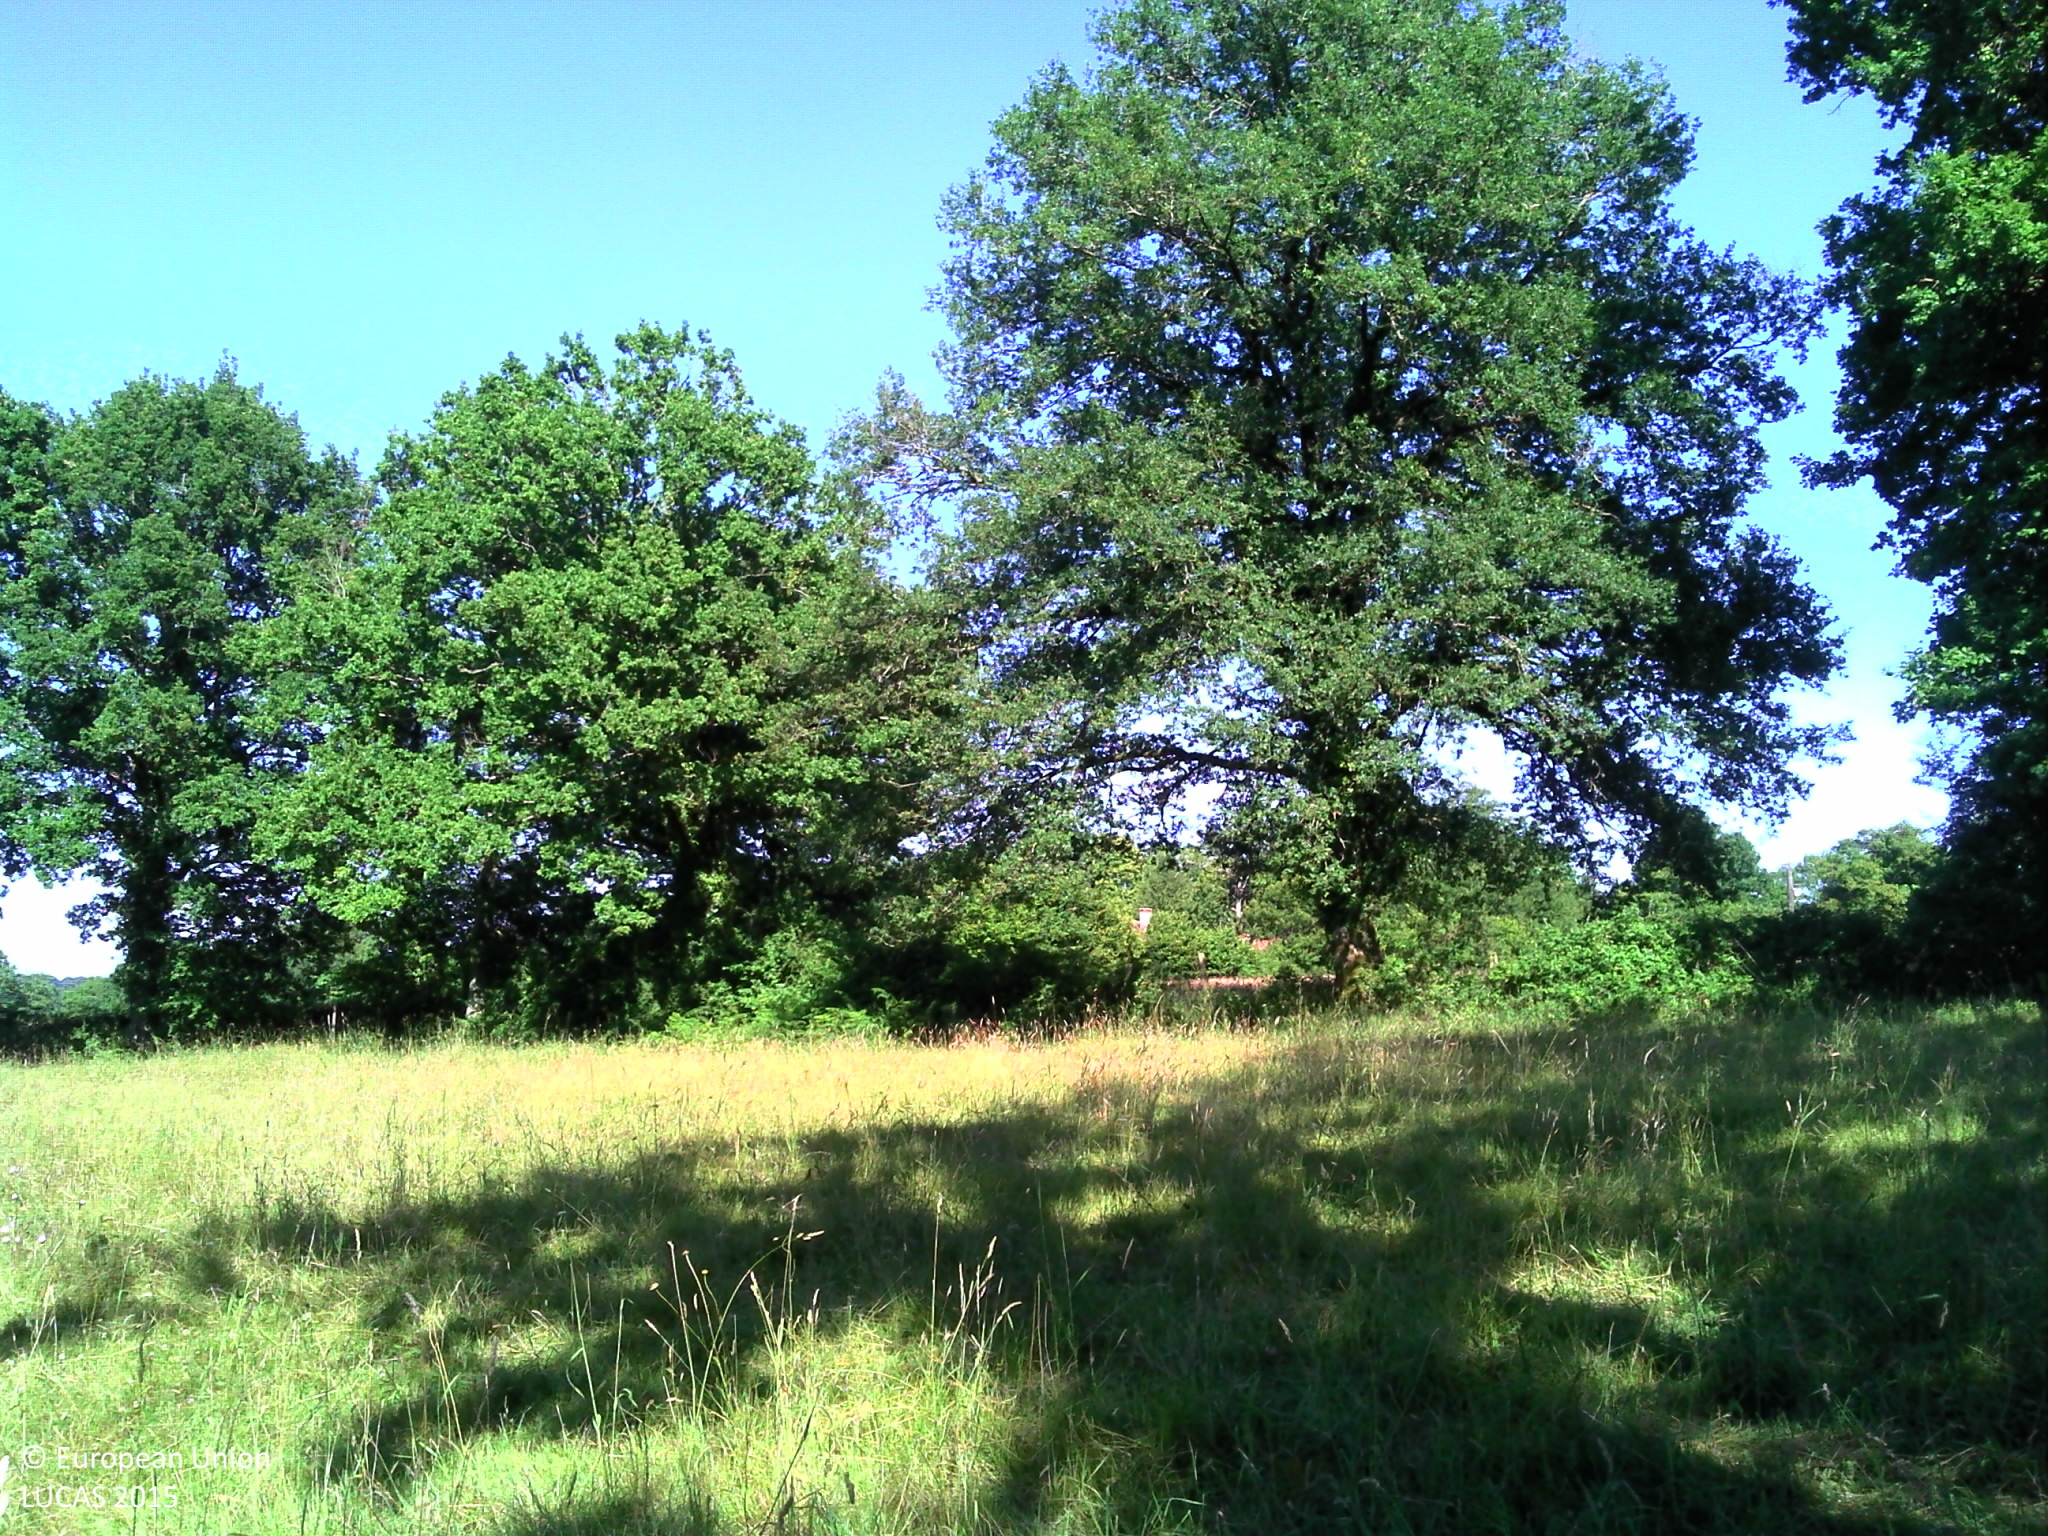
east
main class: Grassland
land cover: Grassland with sparse tree/shrub cover
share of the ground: > 75 %
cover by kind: herbaceous plants 95 %, broadleaved forest trees 5 %
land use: Agriculture (excluding fallow land and kitchen gardens)
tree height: > 5 m
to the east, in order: Grassland with sparse tree/shrub cover; Fences; Grassland without tree/shrub cover; Fences; Grass margins; Tracks; Abandoned hedges; Grassland without tree/shrub cover; Fences; Artificial constructions in urban areas; Fences; Ditches and canals; Grassland without tree/shrub cover; Broadleaved woodland; Fences
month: June
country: FR
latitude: 45.8168
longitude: 0.6819
